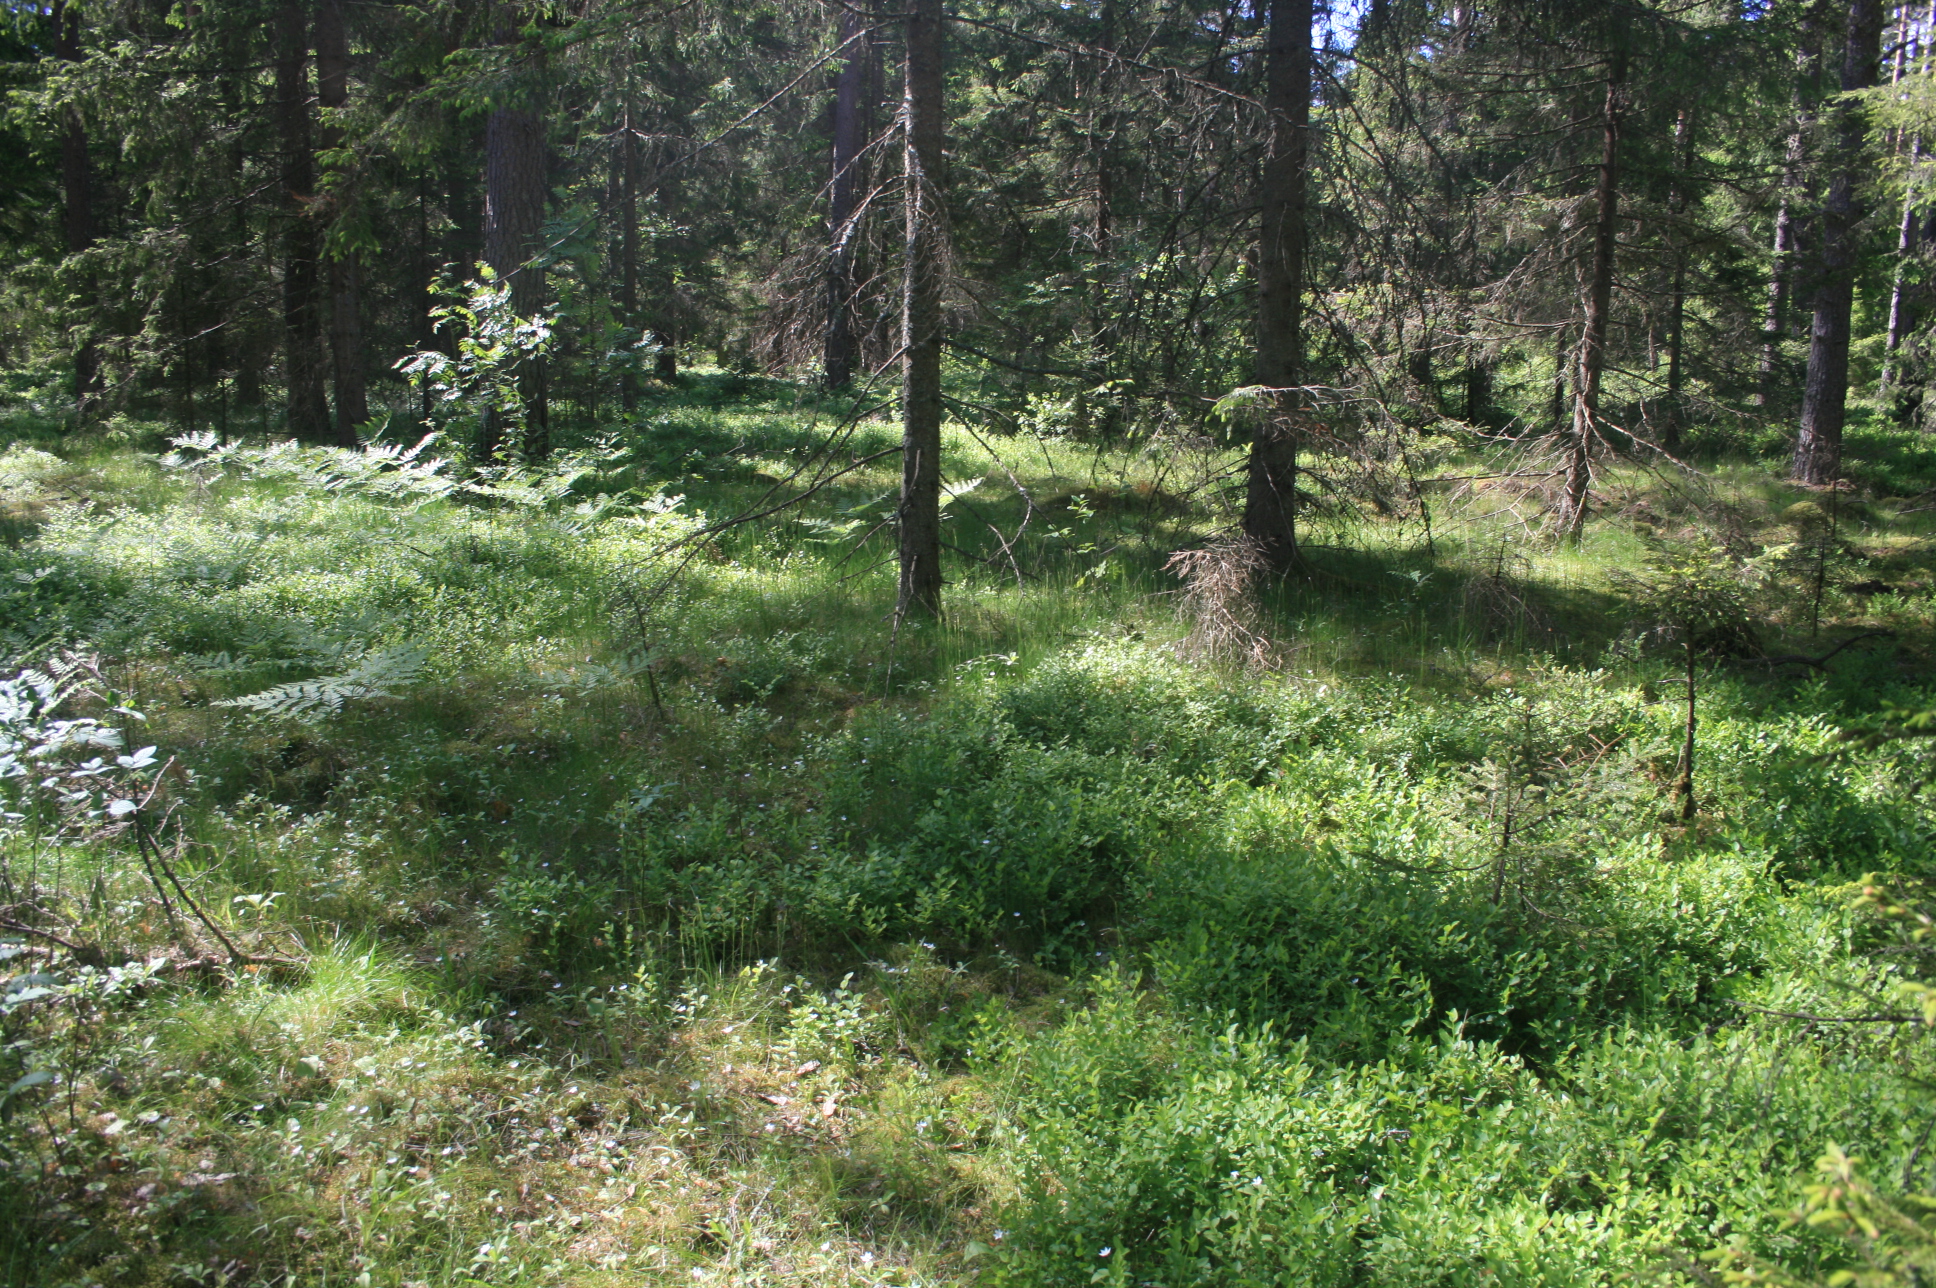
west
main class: Woodland
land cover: Spruce dominated coniferous woodland
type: hemiboreal forest and nemoral coniferous forest and mixed broadleaved-coniferous forest
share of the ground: > 75 %
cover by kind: coniferous forest trees 85 %, broadleaved forest trees 10 %, herbaceous plants 5 %
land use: Forestry
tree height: > 5 m
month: June
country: LT
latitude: 55.7976
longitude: 22.2588
